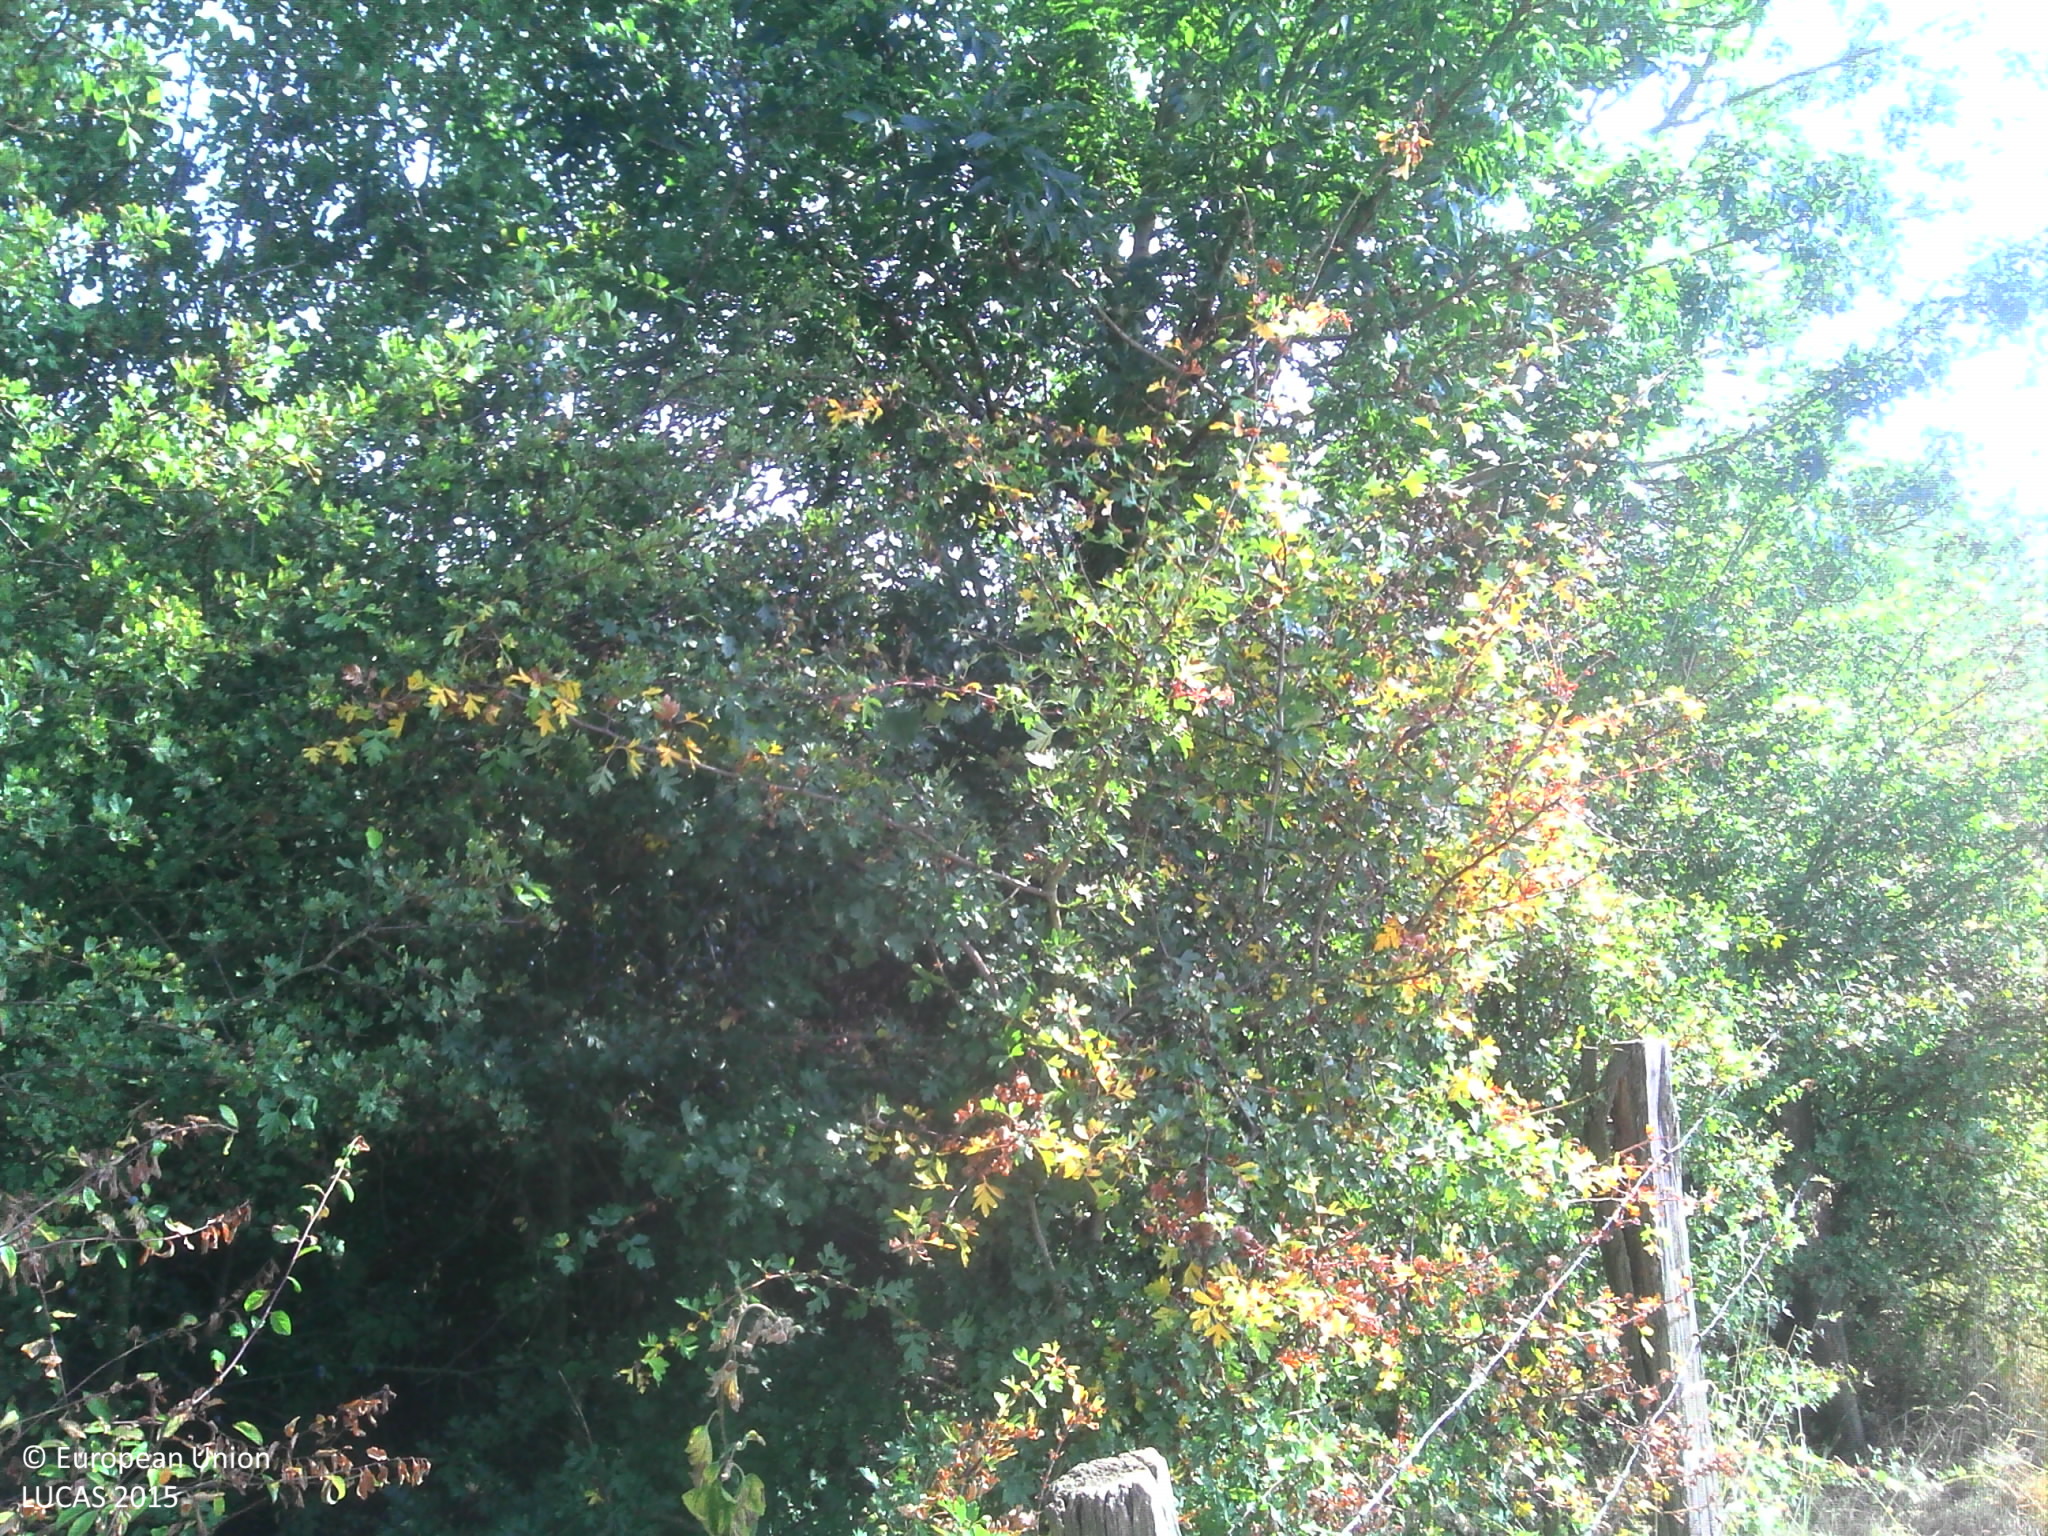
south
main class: Cropland
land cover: Maize
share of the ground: > 75 %
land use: Agriculture (excluding fallow land and kitchen gardens)
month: July
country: FR
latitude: 46.9390
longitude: 5.0226
